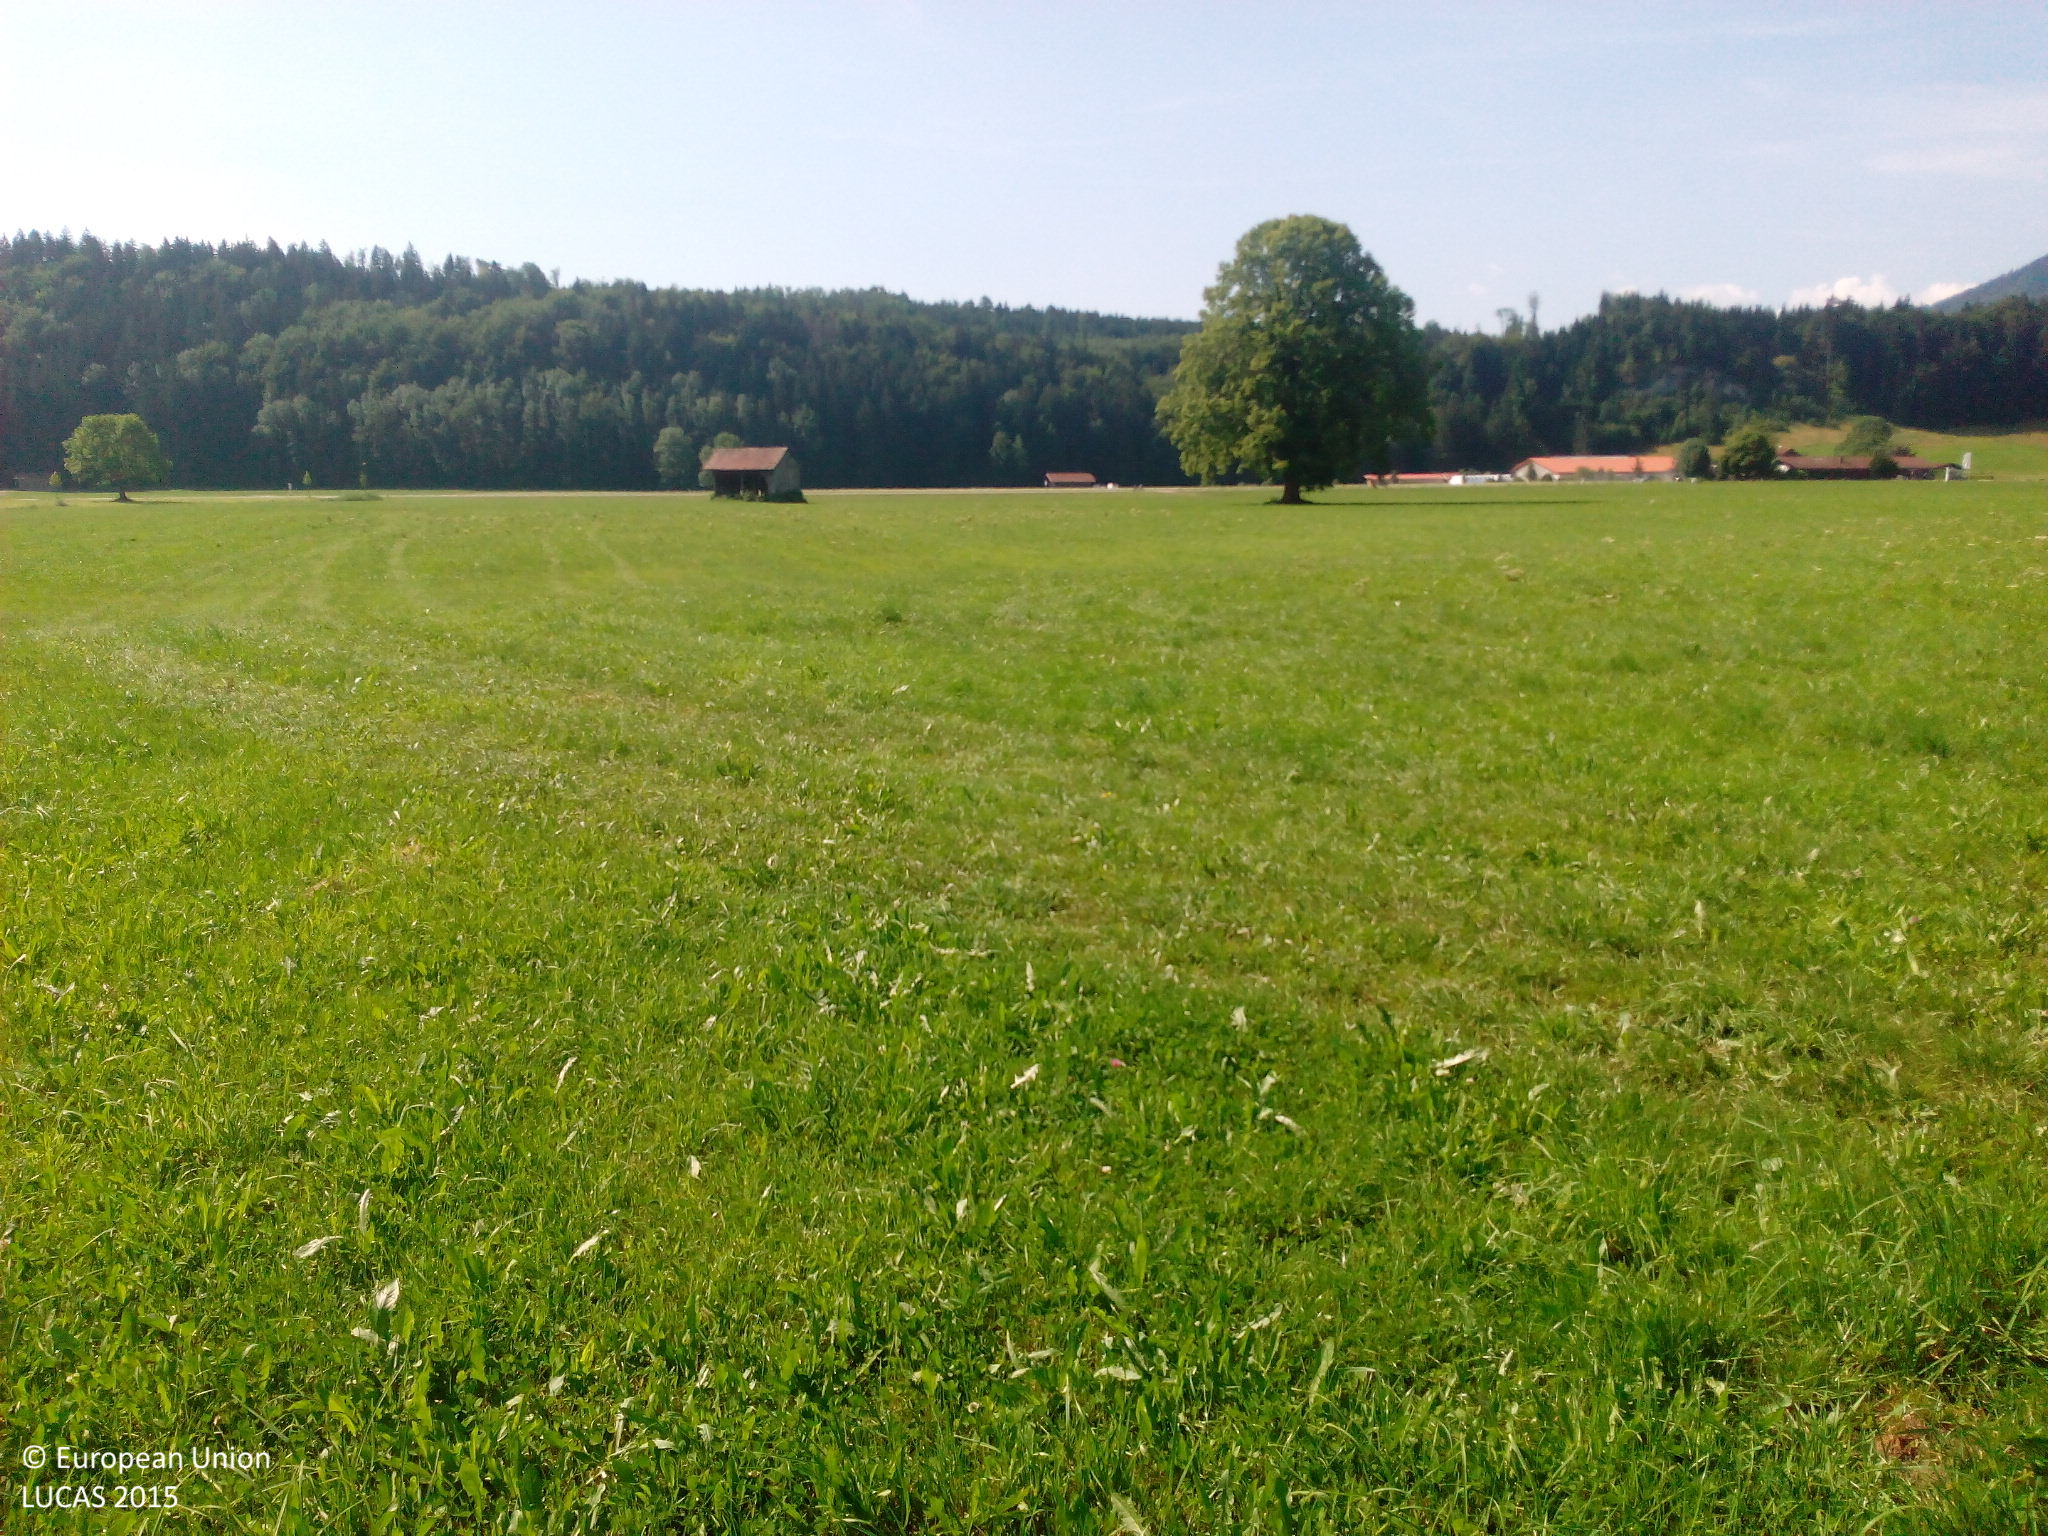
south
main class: Grassland
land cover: Grassland without tree/shrub cover
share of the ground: > 75 %
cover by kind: herbaceous plants 100 %
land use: Agriculture (excluding fallow land and kitchen gardens)
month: July
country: DE
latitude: 47.5753
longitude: 10.2524
